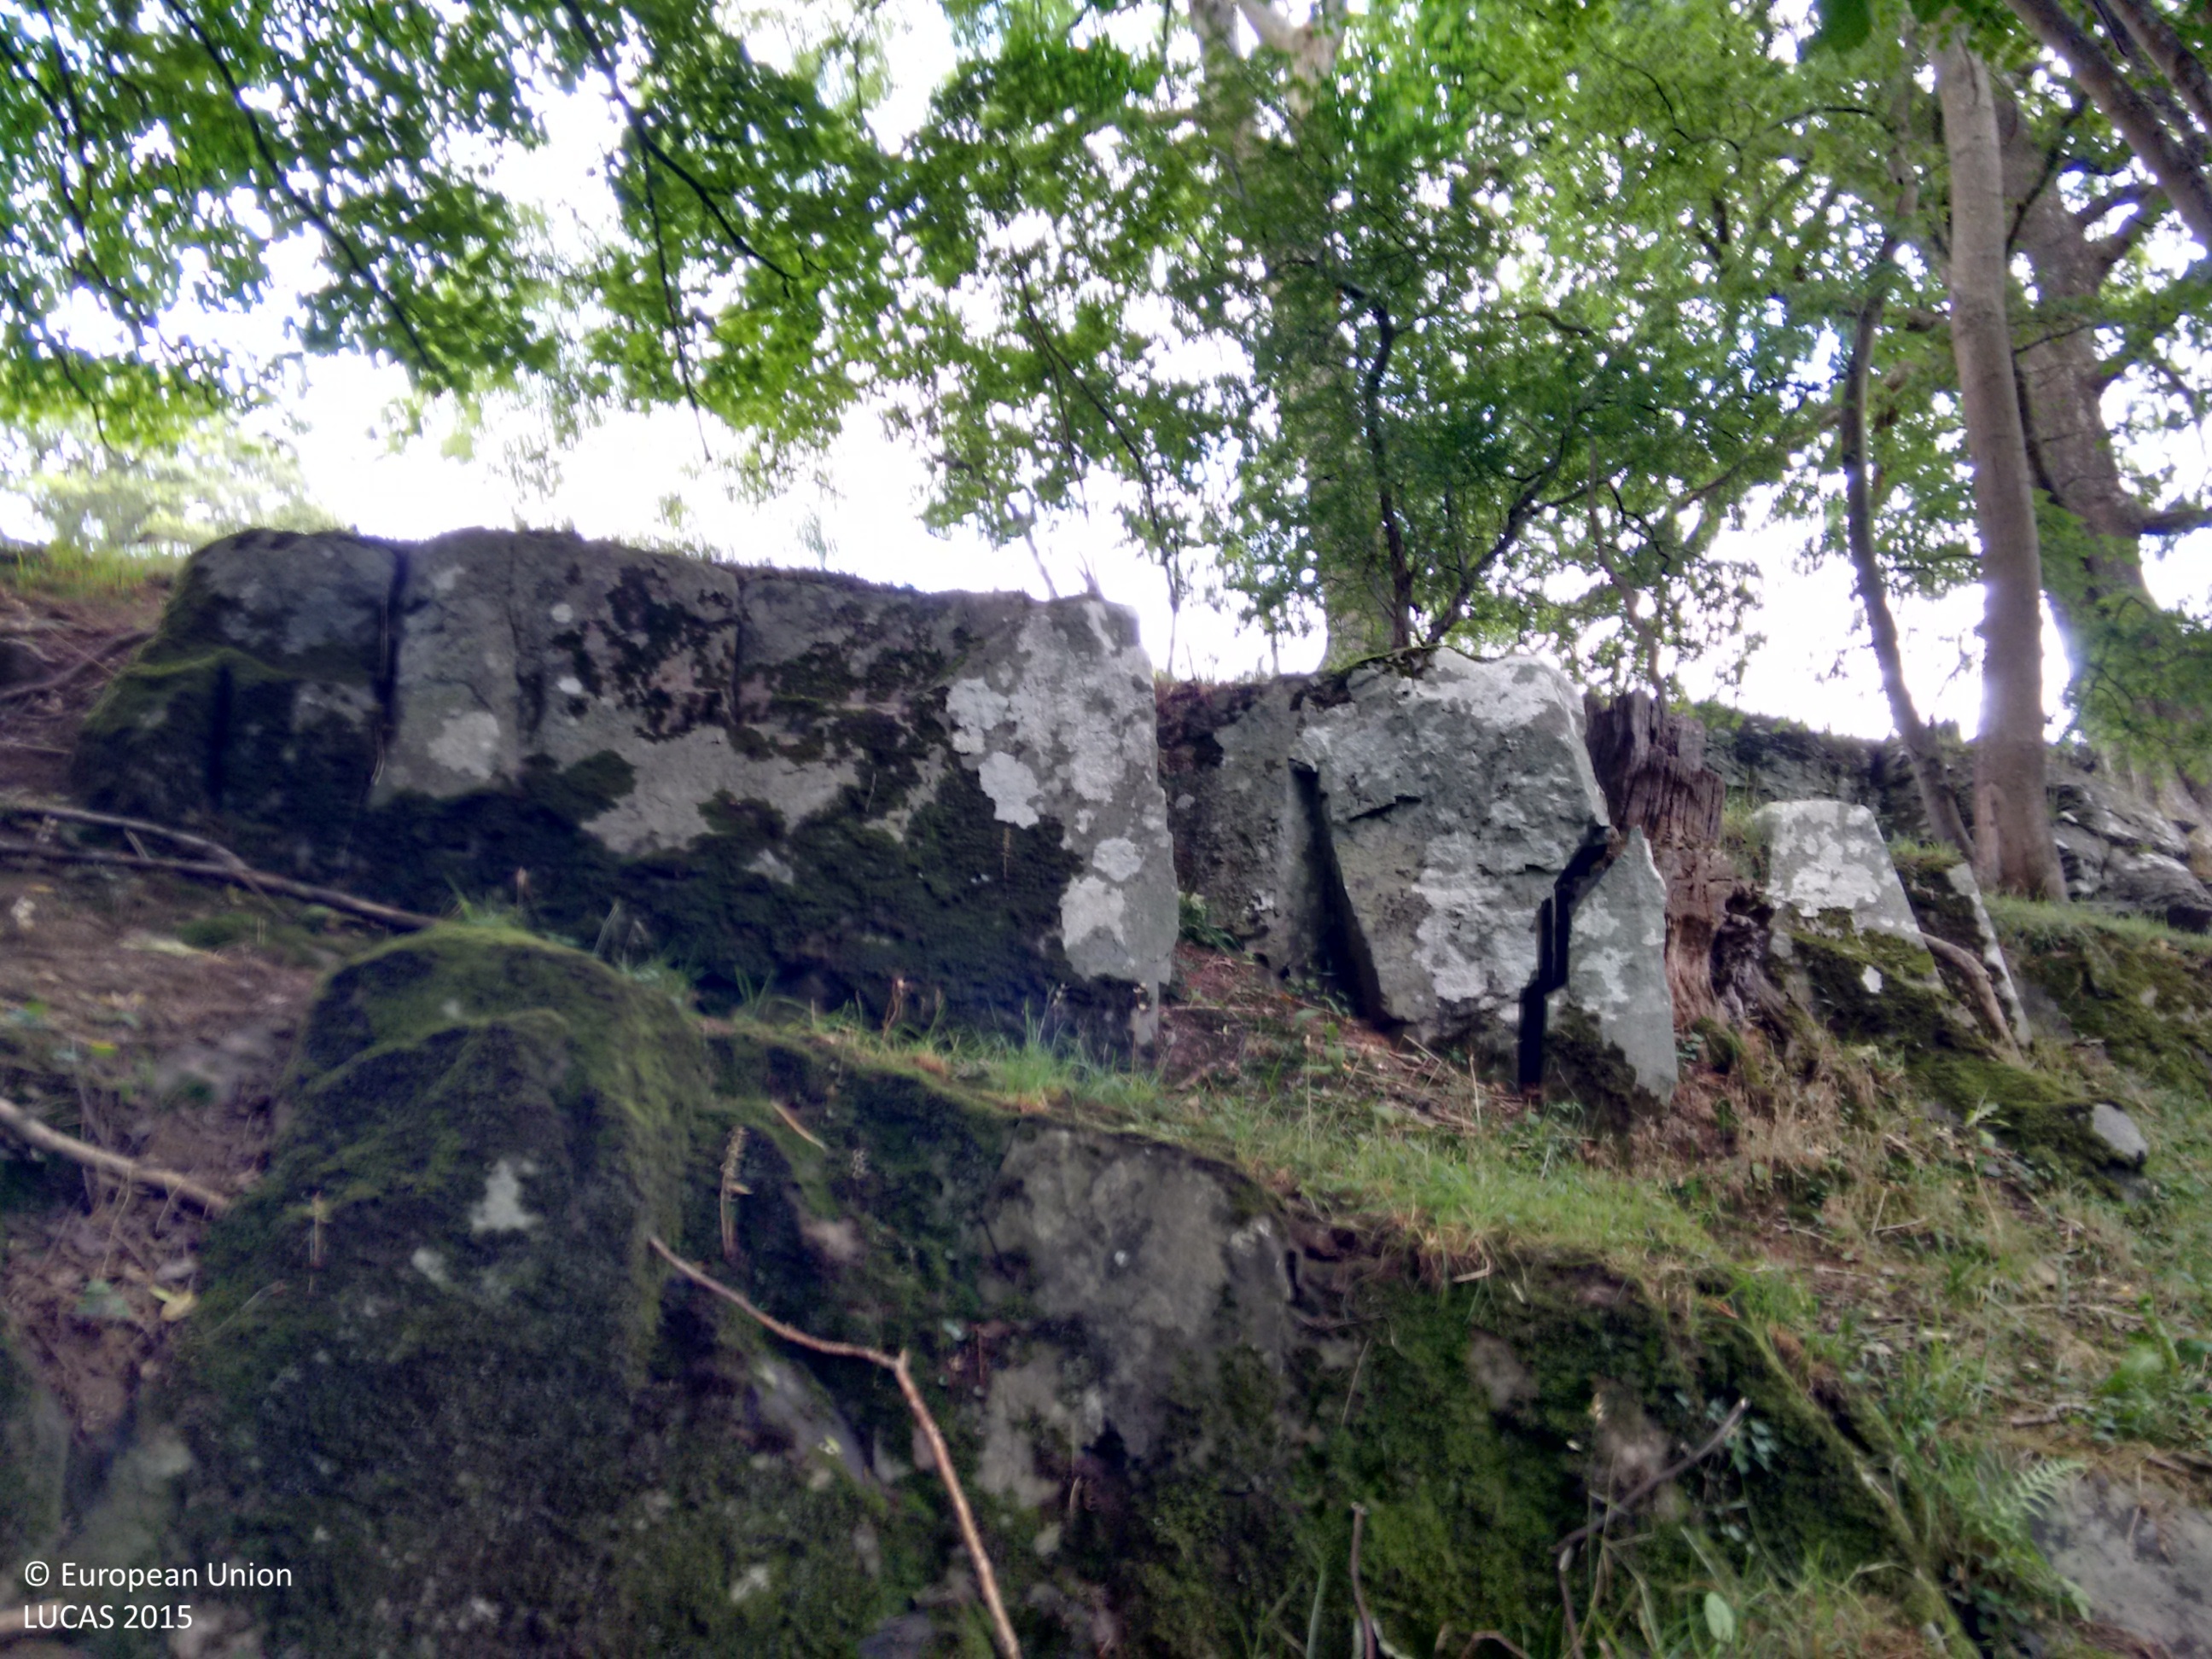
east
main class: Woodland
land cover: Broadleaved woodland
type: mesophytic deciduous forest
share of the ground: > 75 %
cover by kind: broadleaved forest trees 100 %
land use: Agriculture (excluding fallow land and kitchen gardens)
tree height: > 5 m
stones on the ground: 25 - 50 %
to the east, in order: Broadleaved woodland; Fences; Grassland without tree/shrub cover; Fences; Broadleaved woodland; Fences; Broadleaved woodland
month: August
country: GB
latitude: 53.1716
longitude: -3.8085
